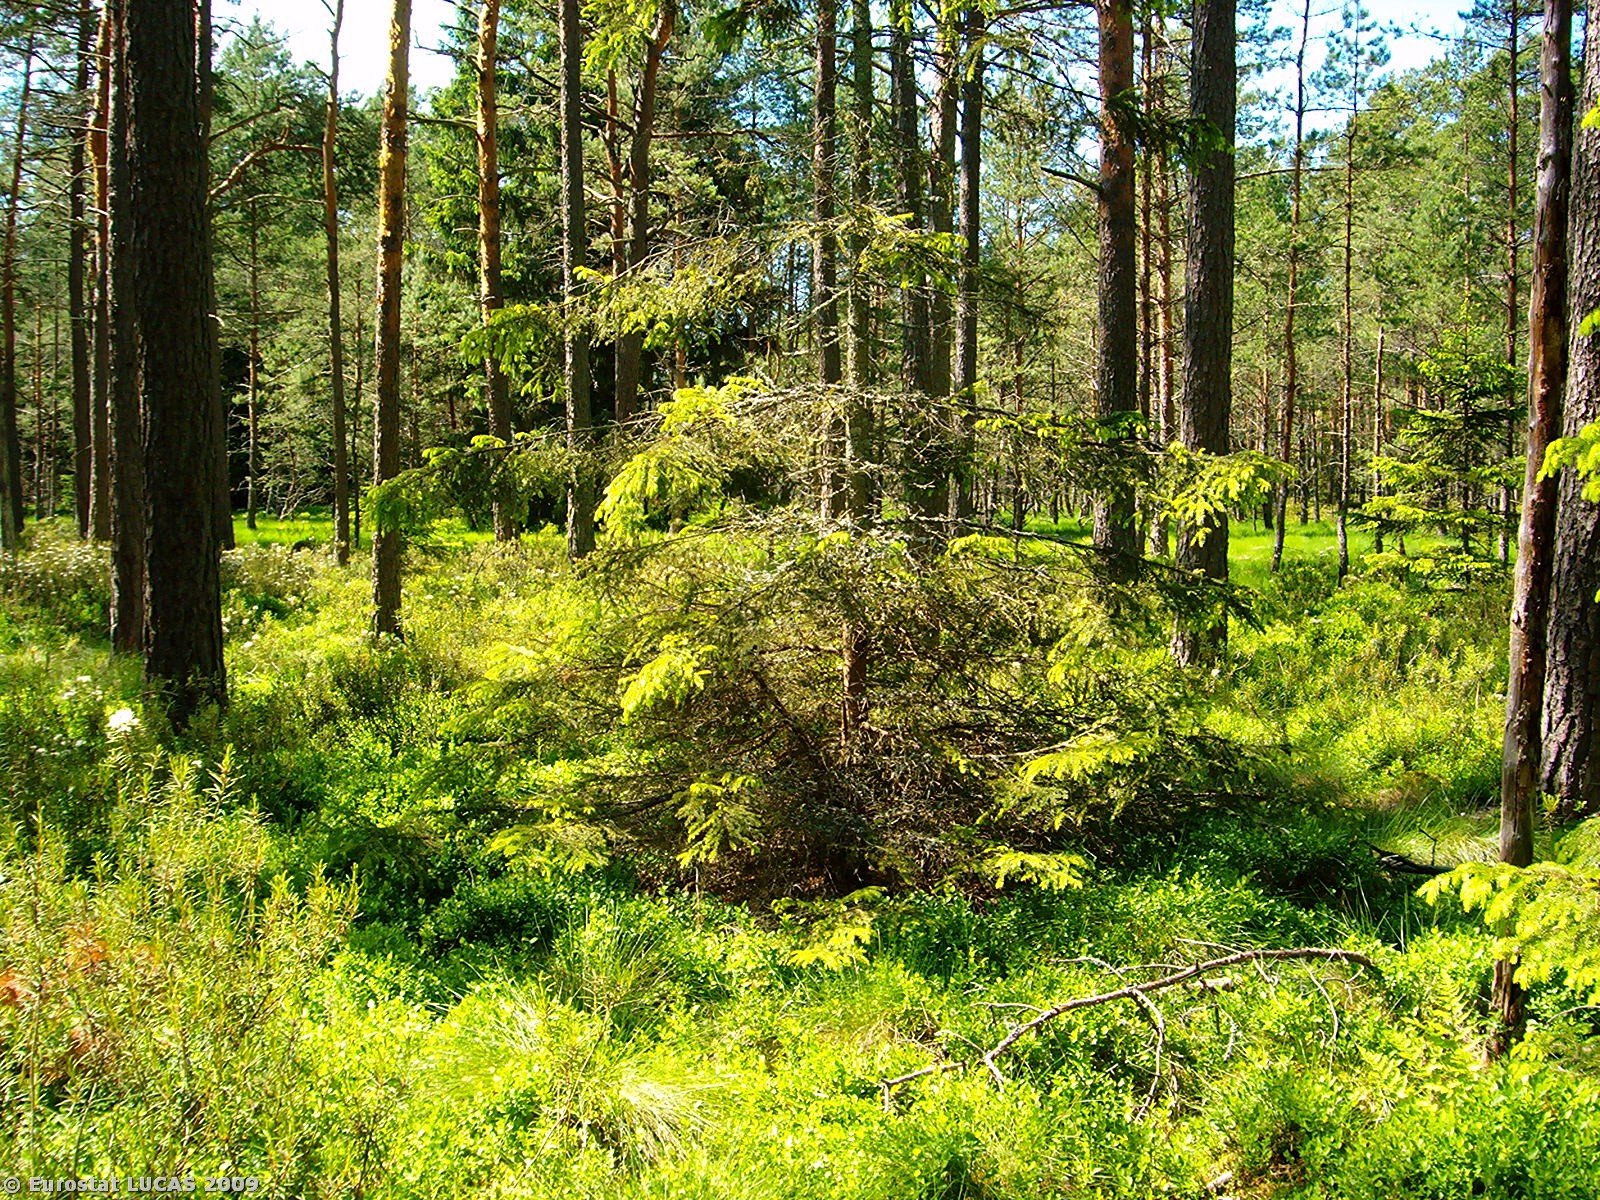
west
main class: Woodland
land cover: Coniferous woodland
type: hemiboreal forest and nemoral coniferous forest and mixed broadleaved-coniferous forest
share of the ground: 50 - 75 %
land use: Forestry
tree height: > 5 m
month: June
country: PL
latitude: 53.9089
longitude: 17.2099
